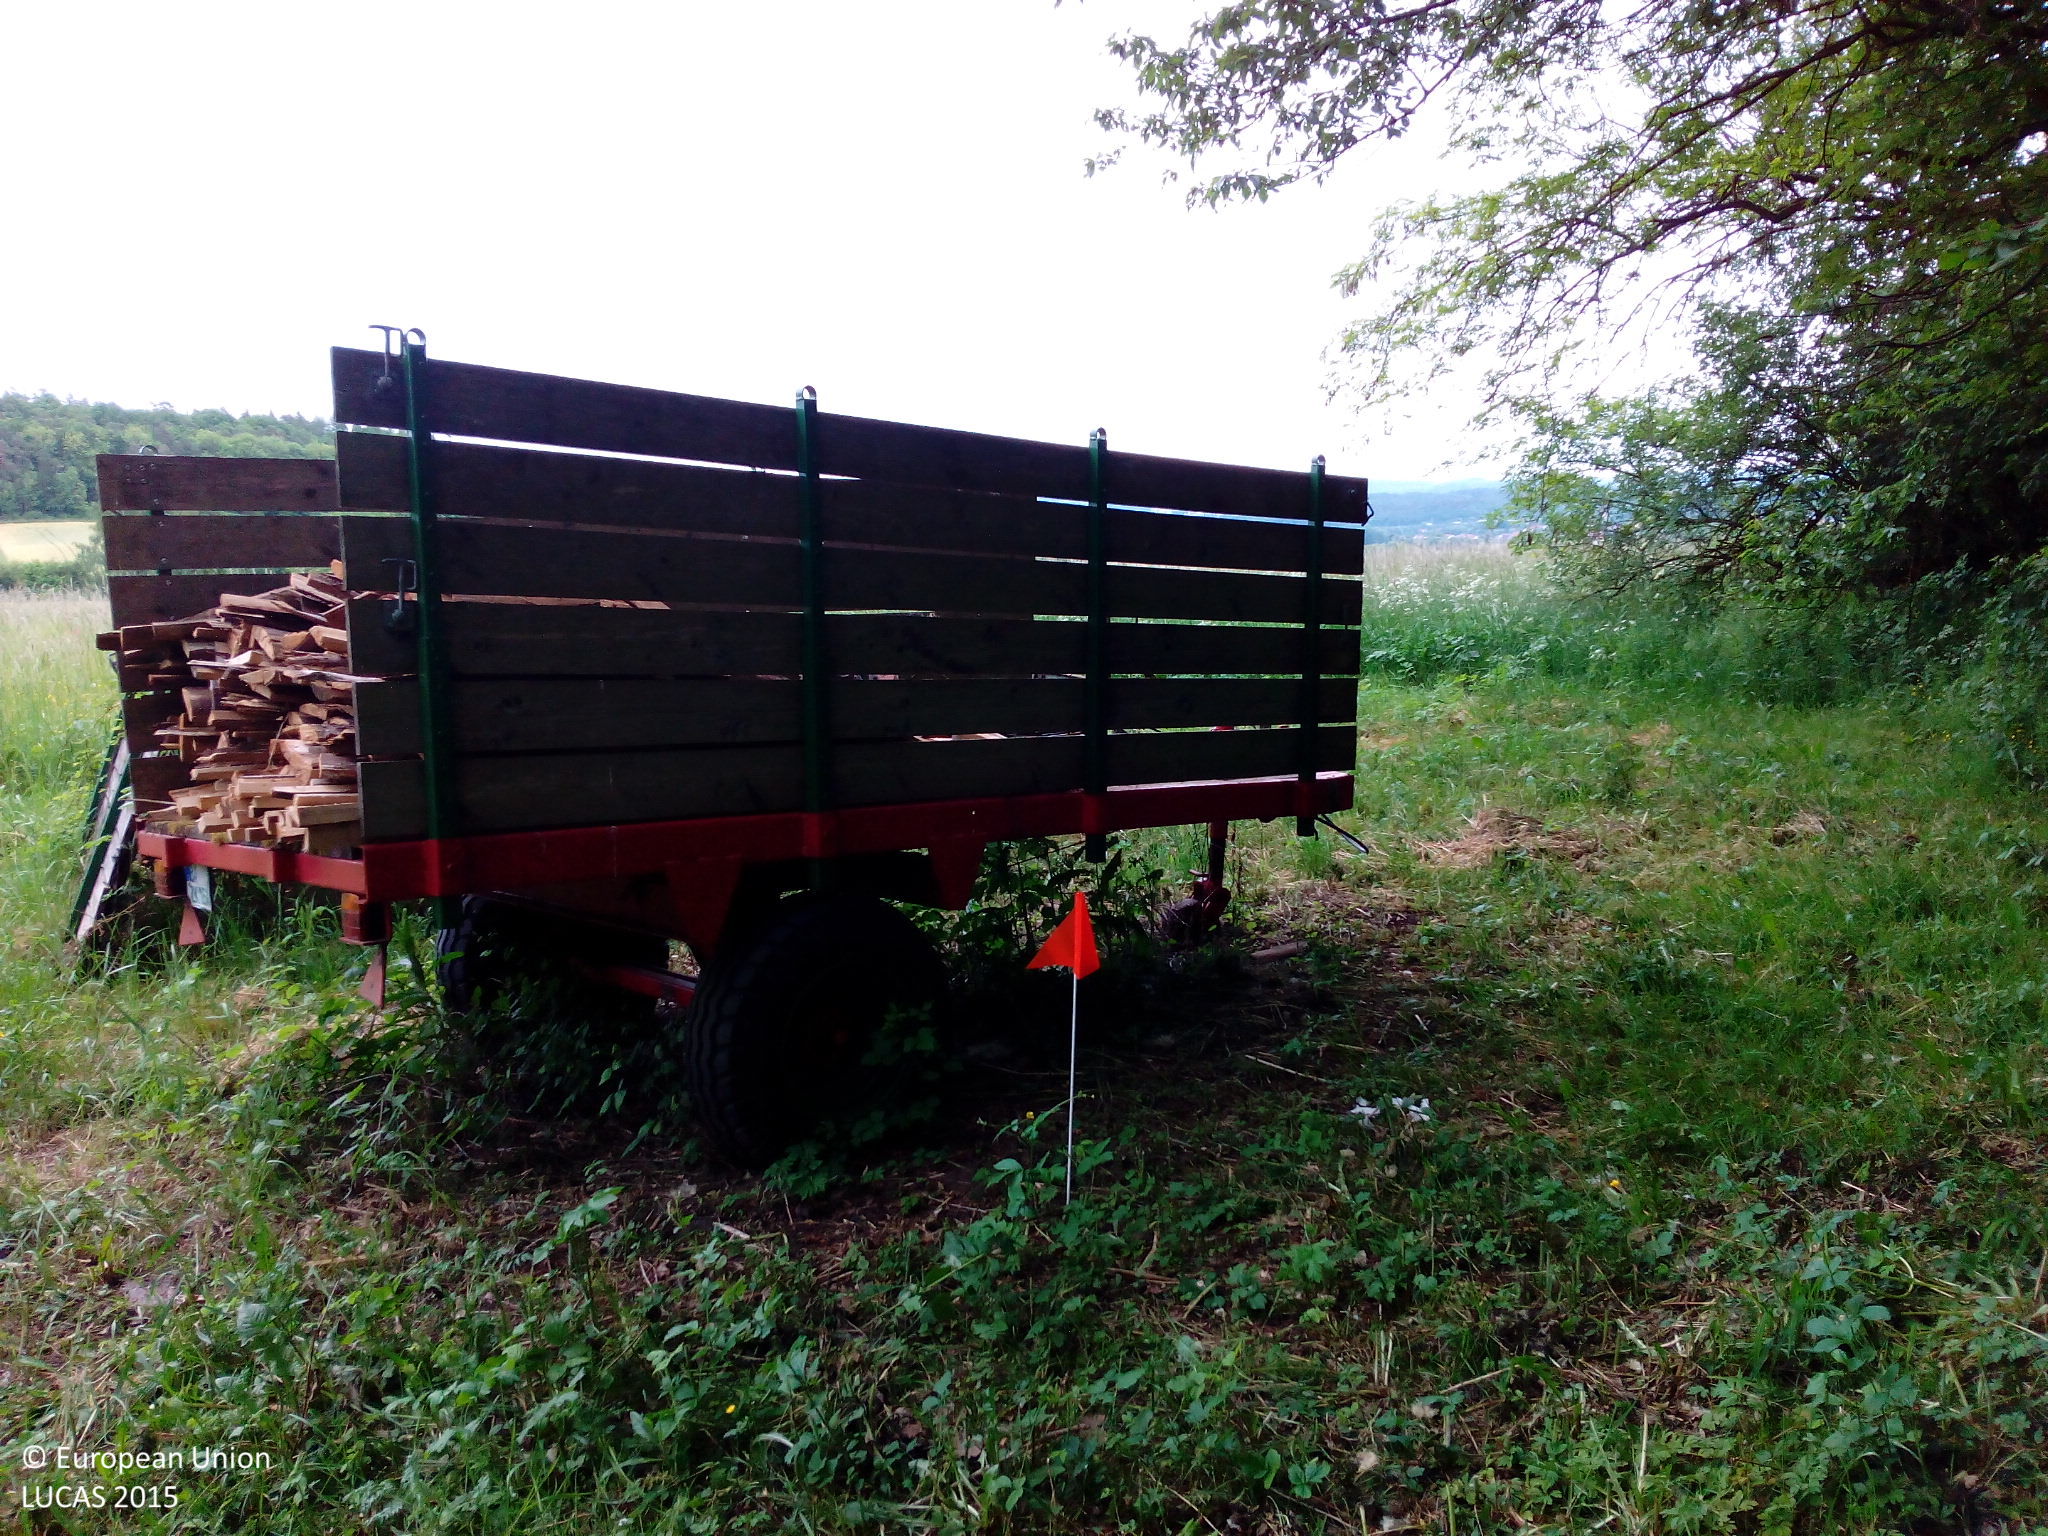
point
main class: Grassland
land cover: Grassland without tree/shrub cover
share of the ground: > 75 %
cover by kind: herbaceous plants 100 %
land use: Agriculture (excluding fallow land and kitchen gardens)
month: June
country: DE
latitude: 50.0367
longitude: 10.9072
